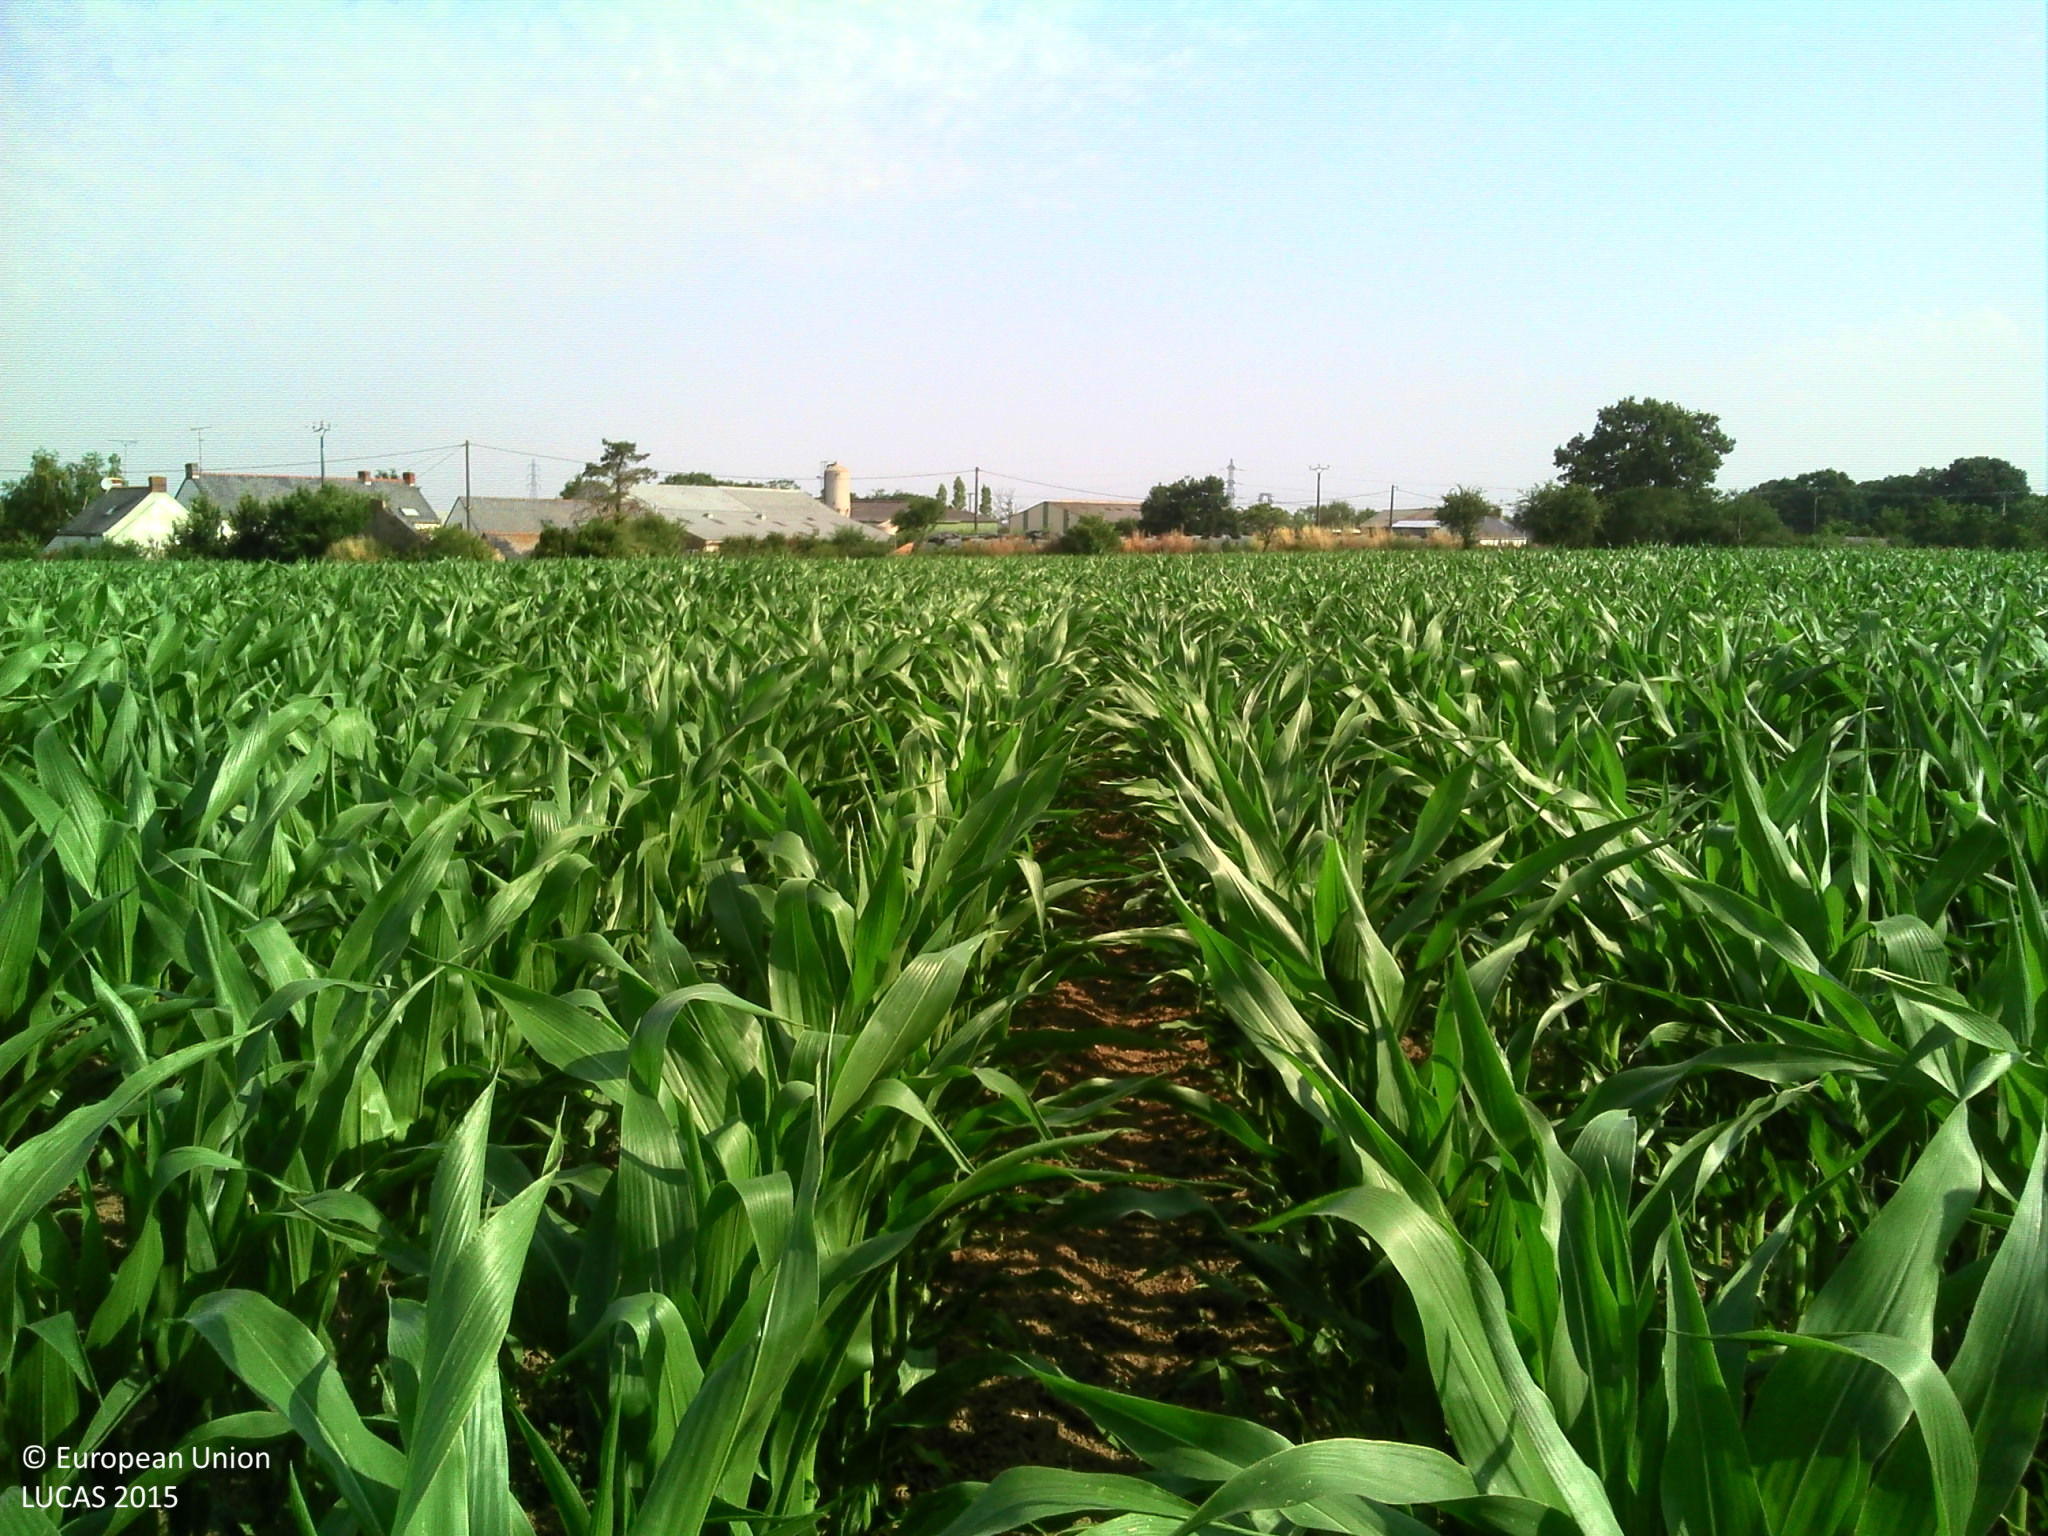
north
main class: Cropland
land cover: Maize
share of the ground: > 75 %
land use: Agriculture (excluding fallow land and kitchen gardens)
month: July
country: FR
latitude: 47.3172
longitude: -1.9411
